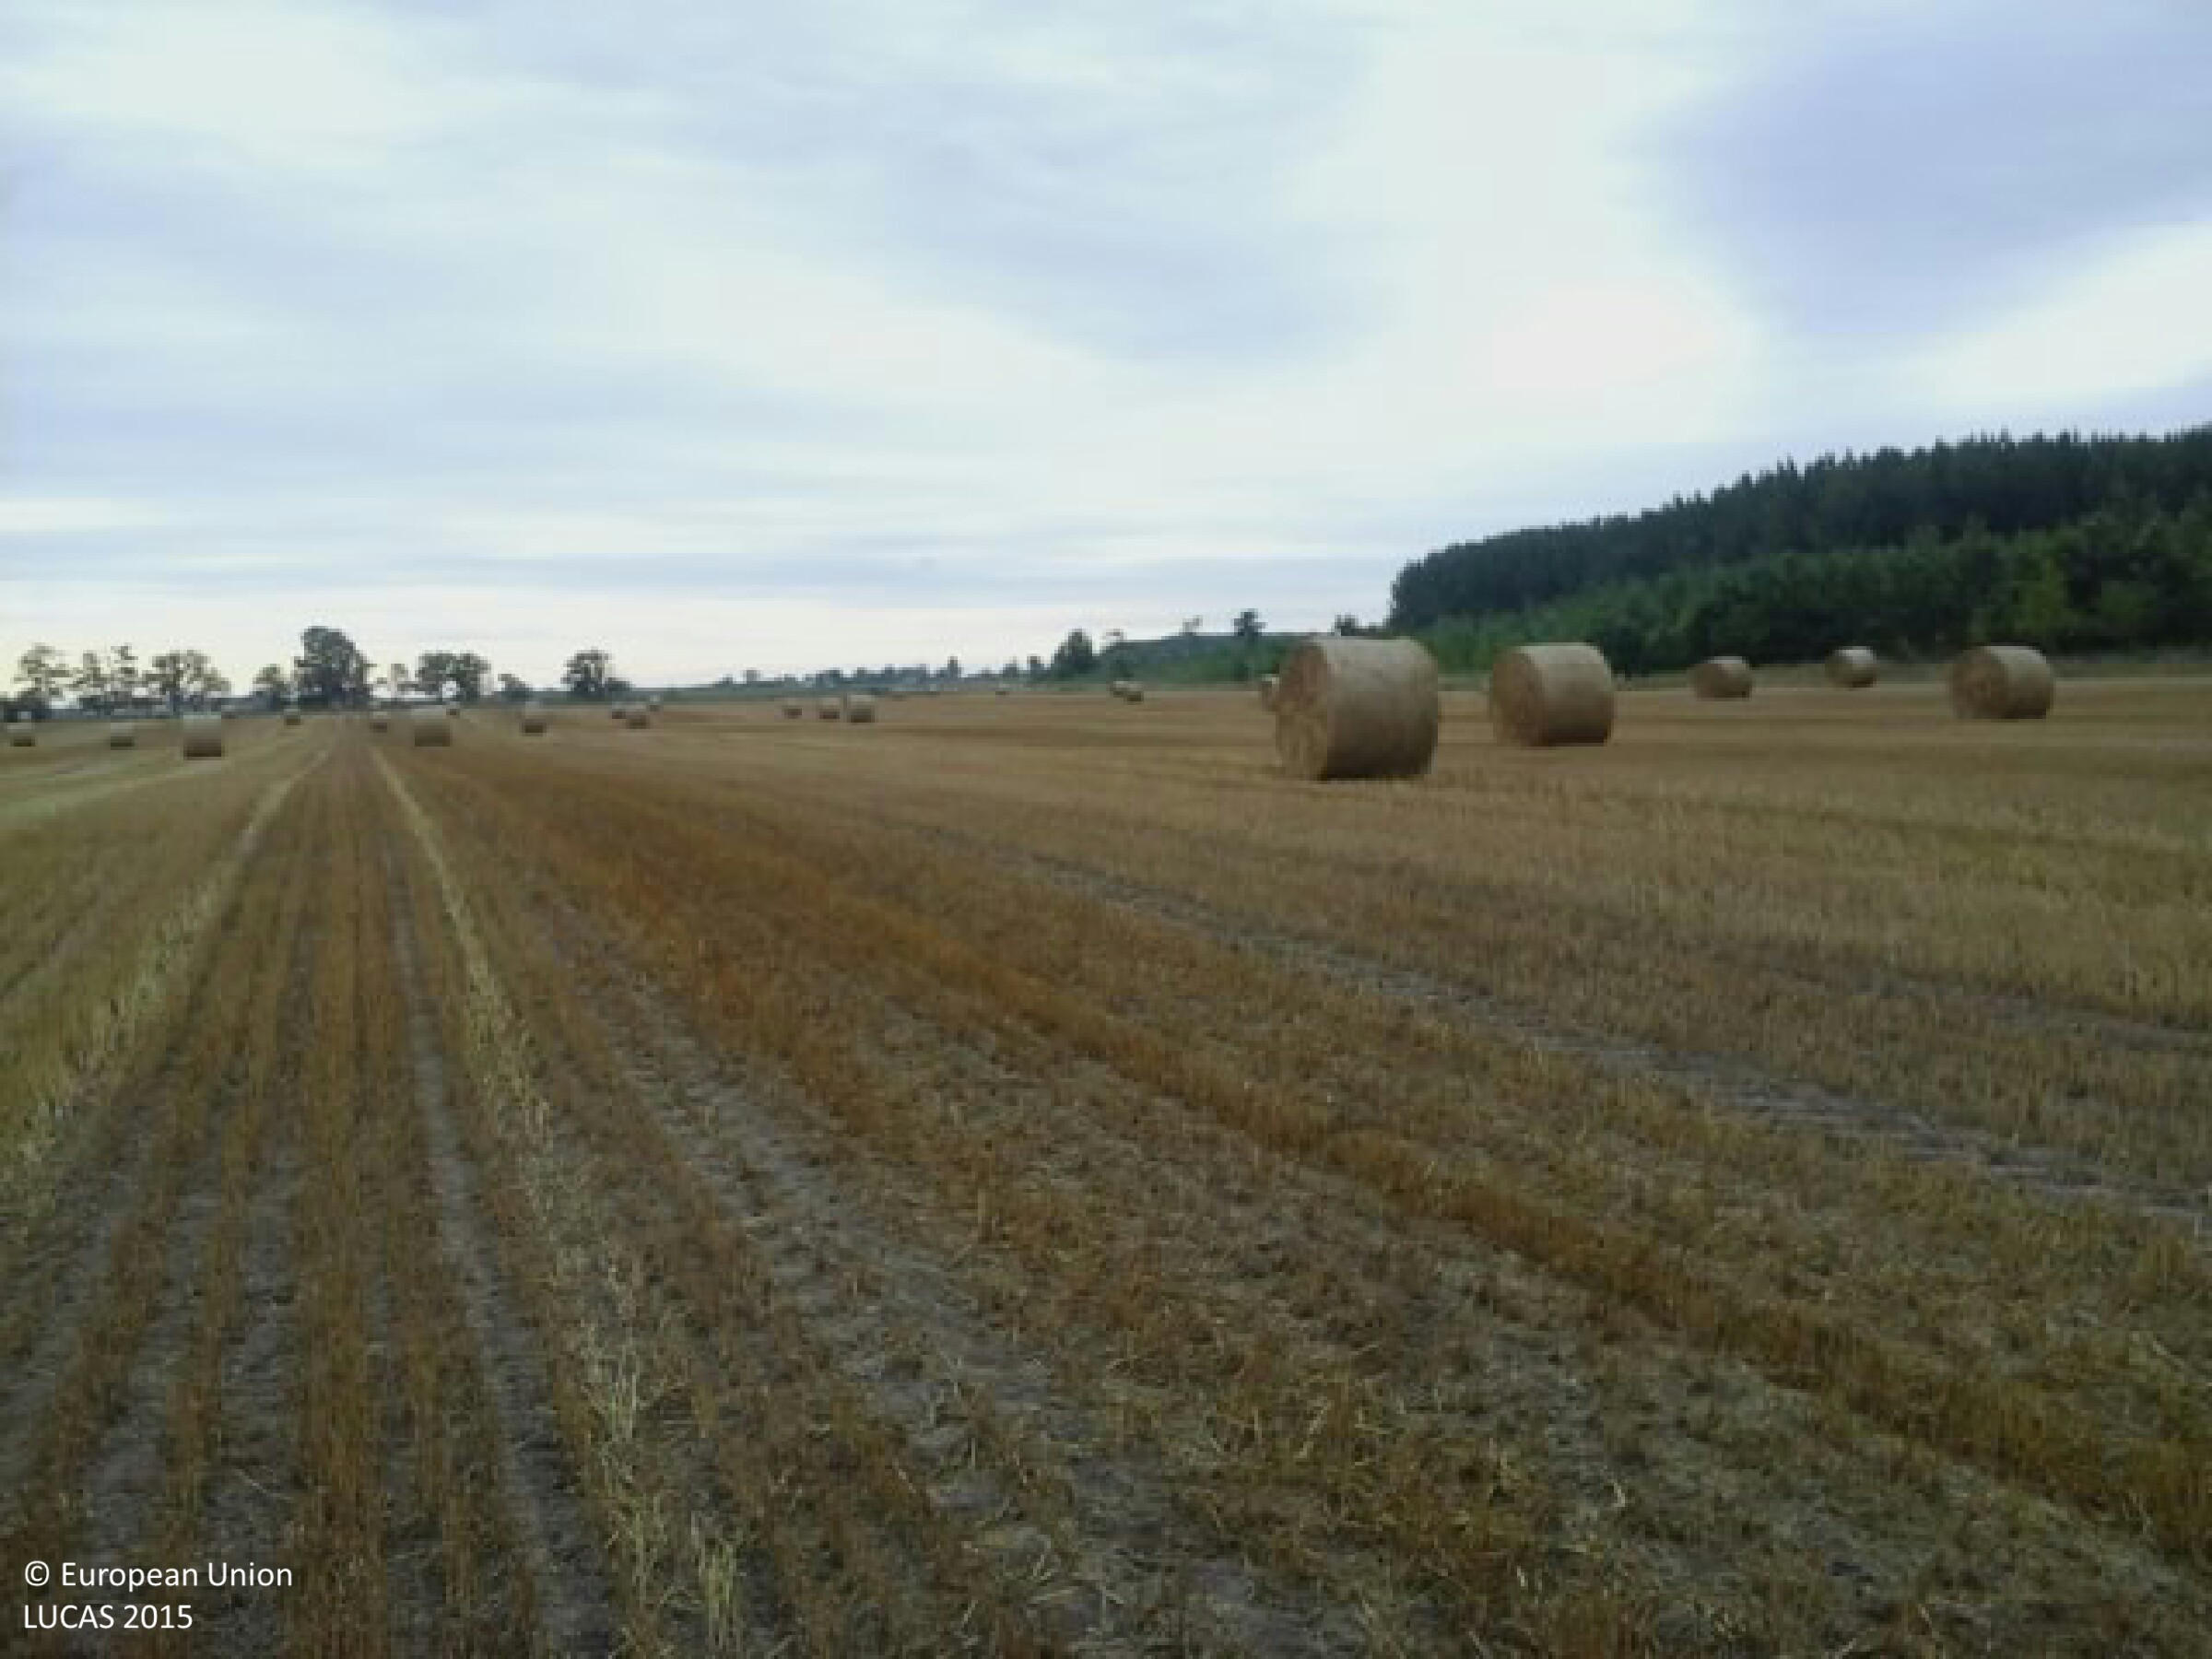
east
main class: Cropland
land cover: Common wheat
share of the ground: 25 - 50 %
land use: Agriculture (excluding fallow land and kitchen gardens)
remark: Harvested field
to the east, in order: Common wheat
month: July
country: HU
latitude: 46.9534
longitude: 19.7846
